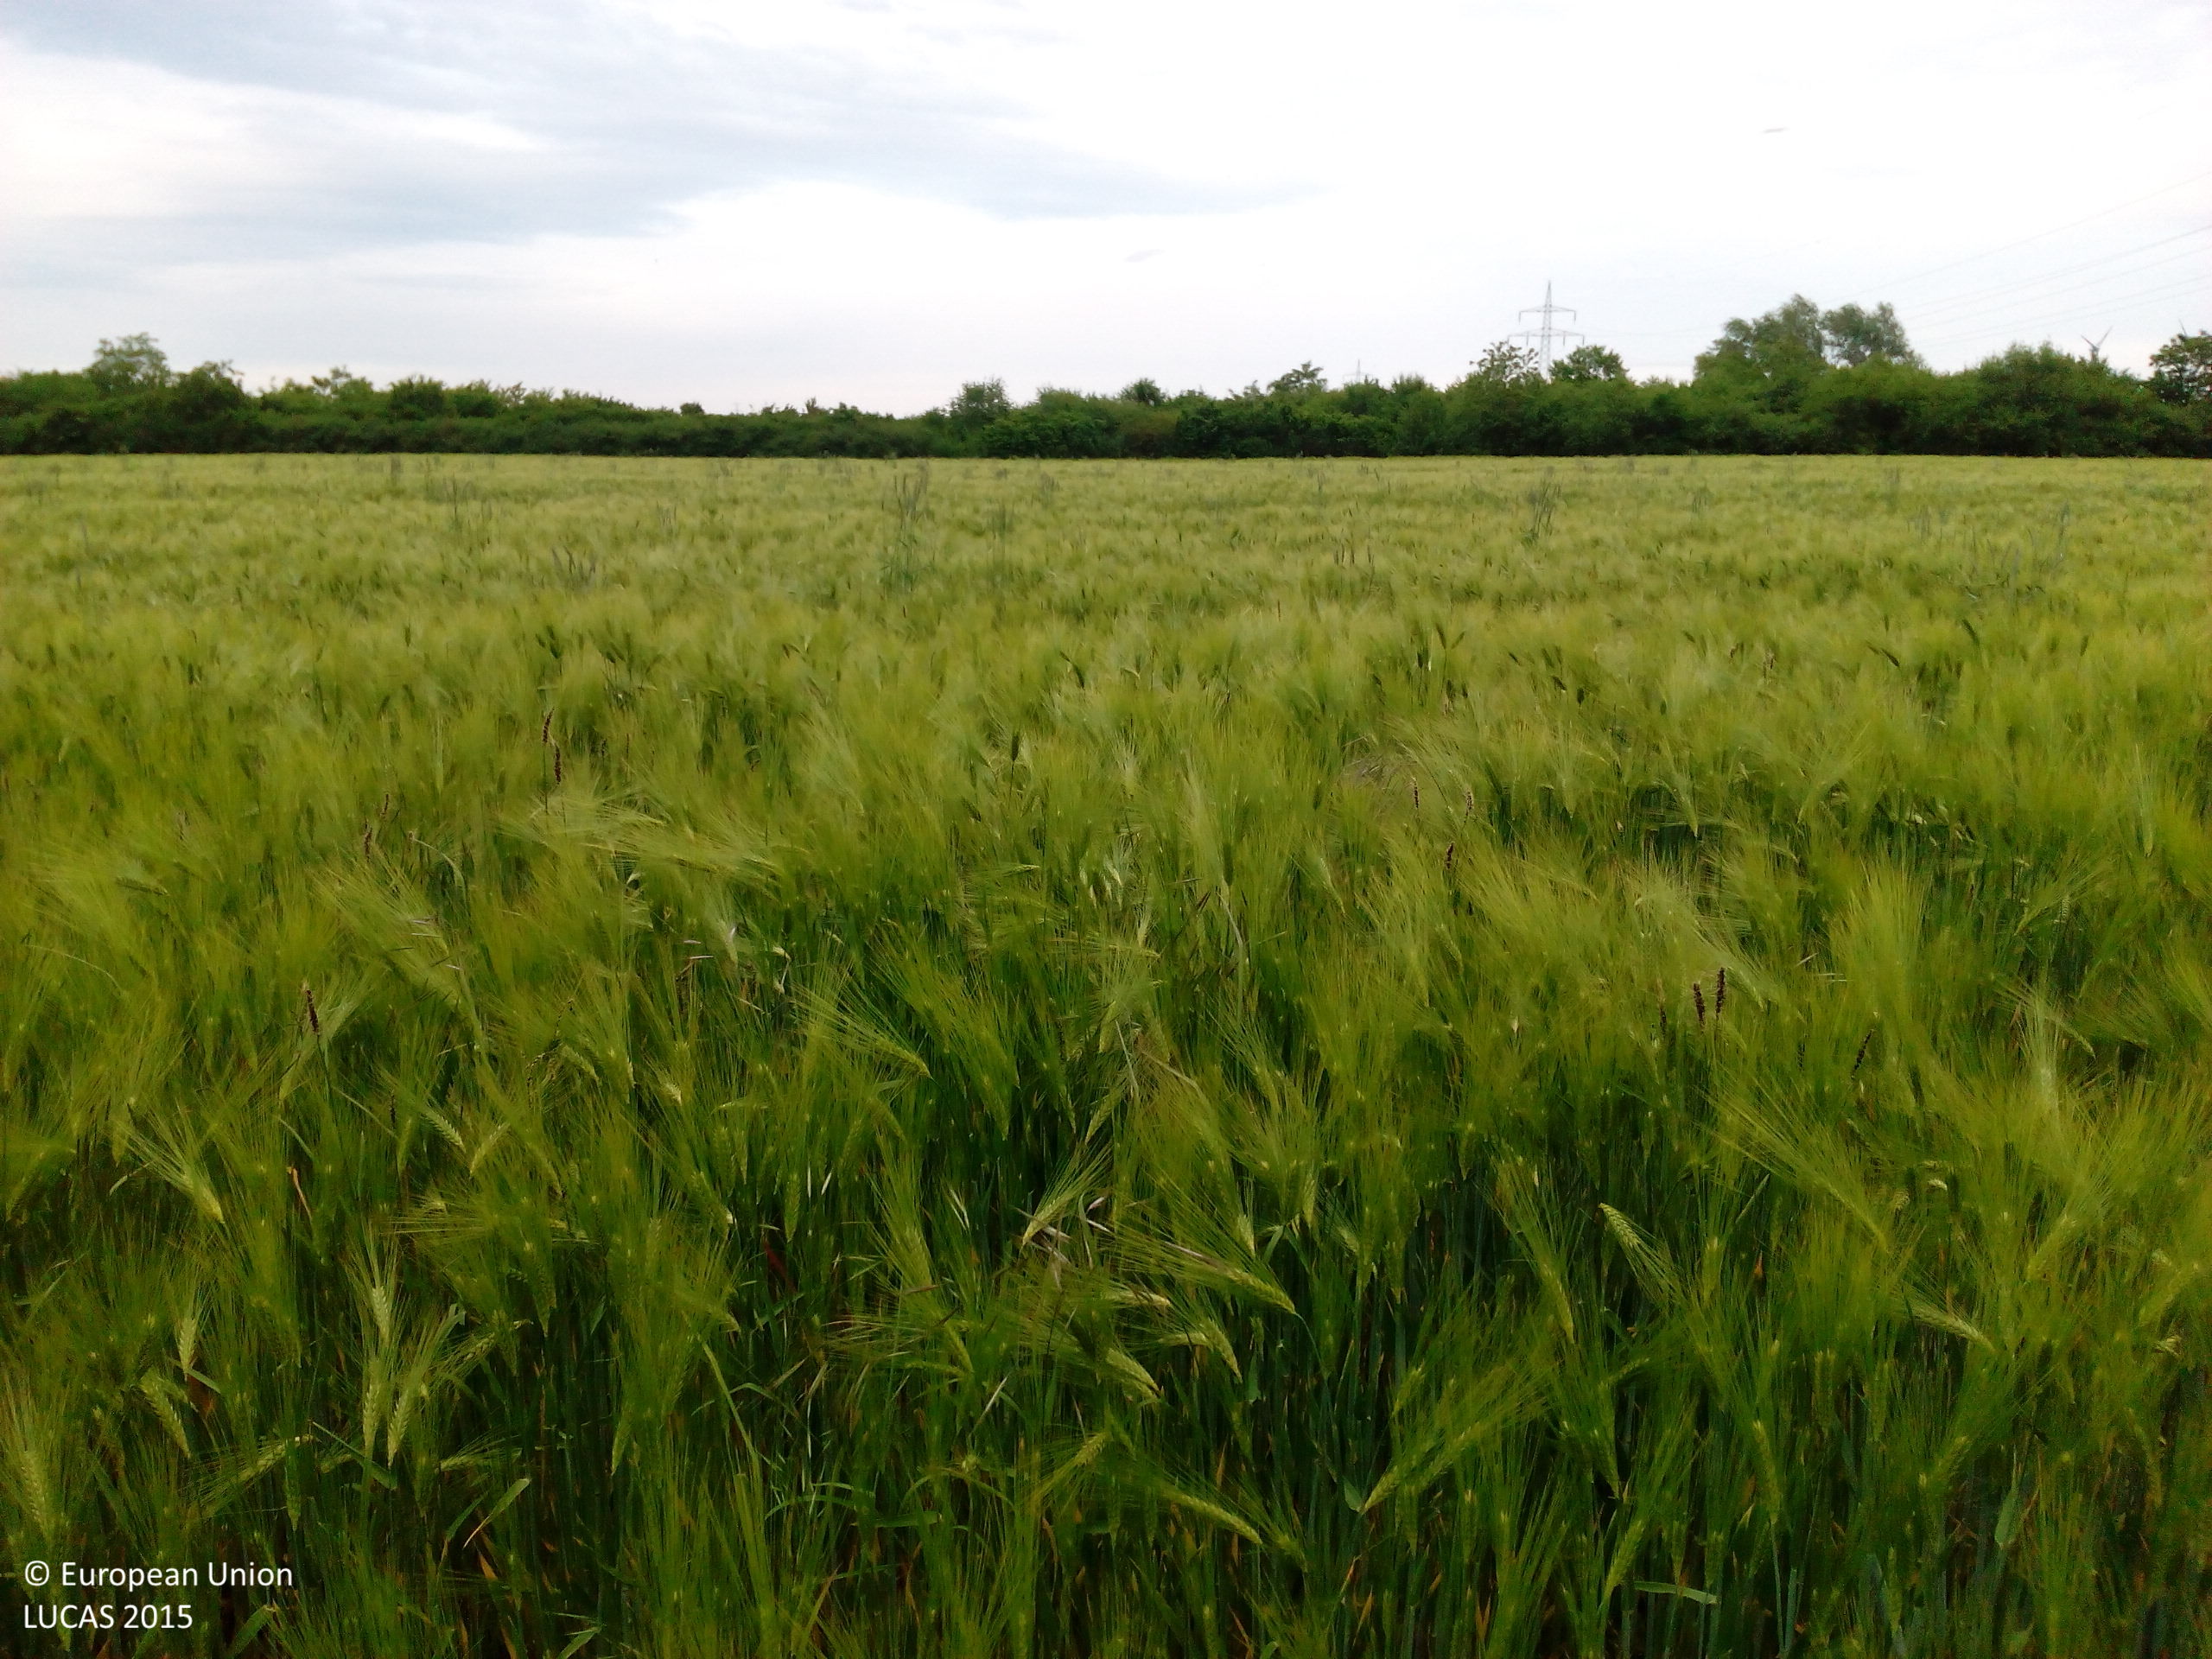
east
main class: Cropland
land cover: Barley
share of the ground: > 75 %
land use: Agriculture (excluding fallow land and kitchen gardens)
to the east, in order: Barley; Abandoned hedges; Fences; Broadleaved woodland; Grass margins; Paved roads, cycling and walking lanes; Grass margins; Broadleaved woodland; Fences; Abandoned hedges; Common wheat
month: May
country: DE
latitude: 51.7275
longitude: 12.2148
